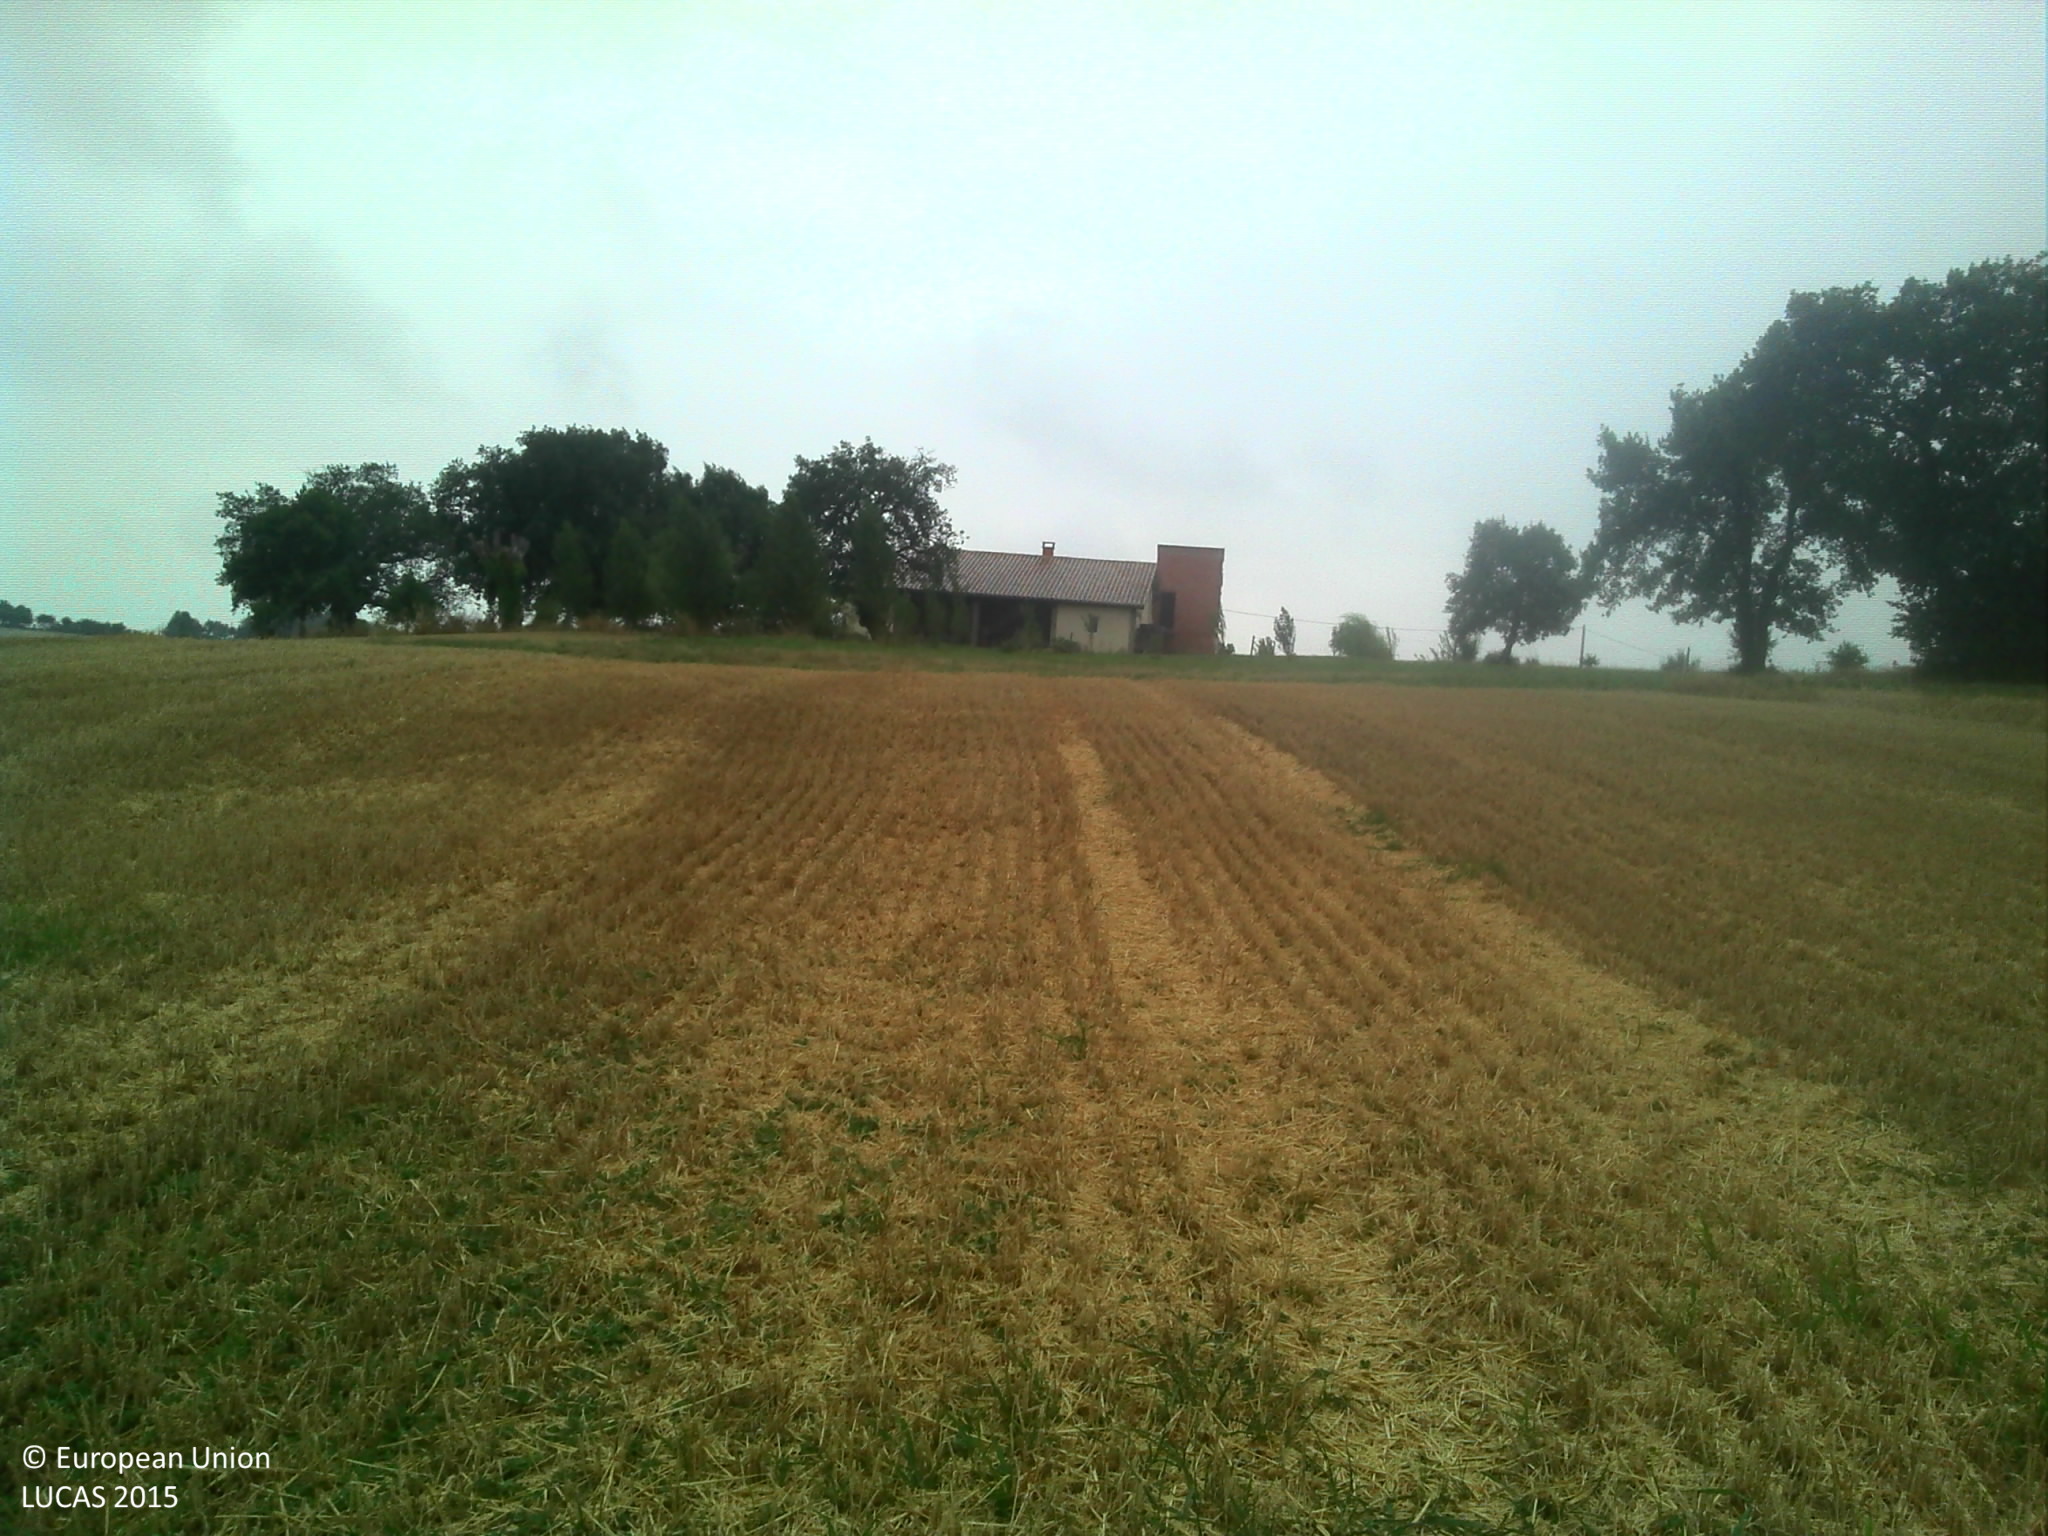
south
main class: Cropland
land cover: Common wheat
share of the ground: > 75 %
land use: Agriculture (excluding fallow land and kitchen gardens)
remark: Harvested field
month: July
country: FR
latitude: 43.9670
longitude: 0.8865
